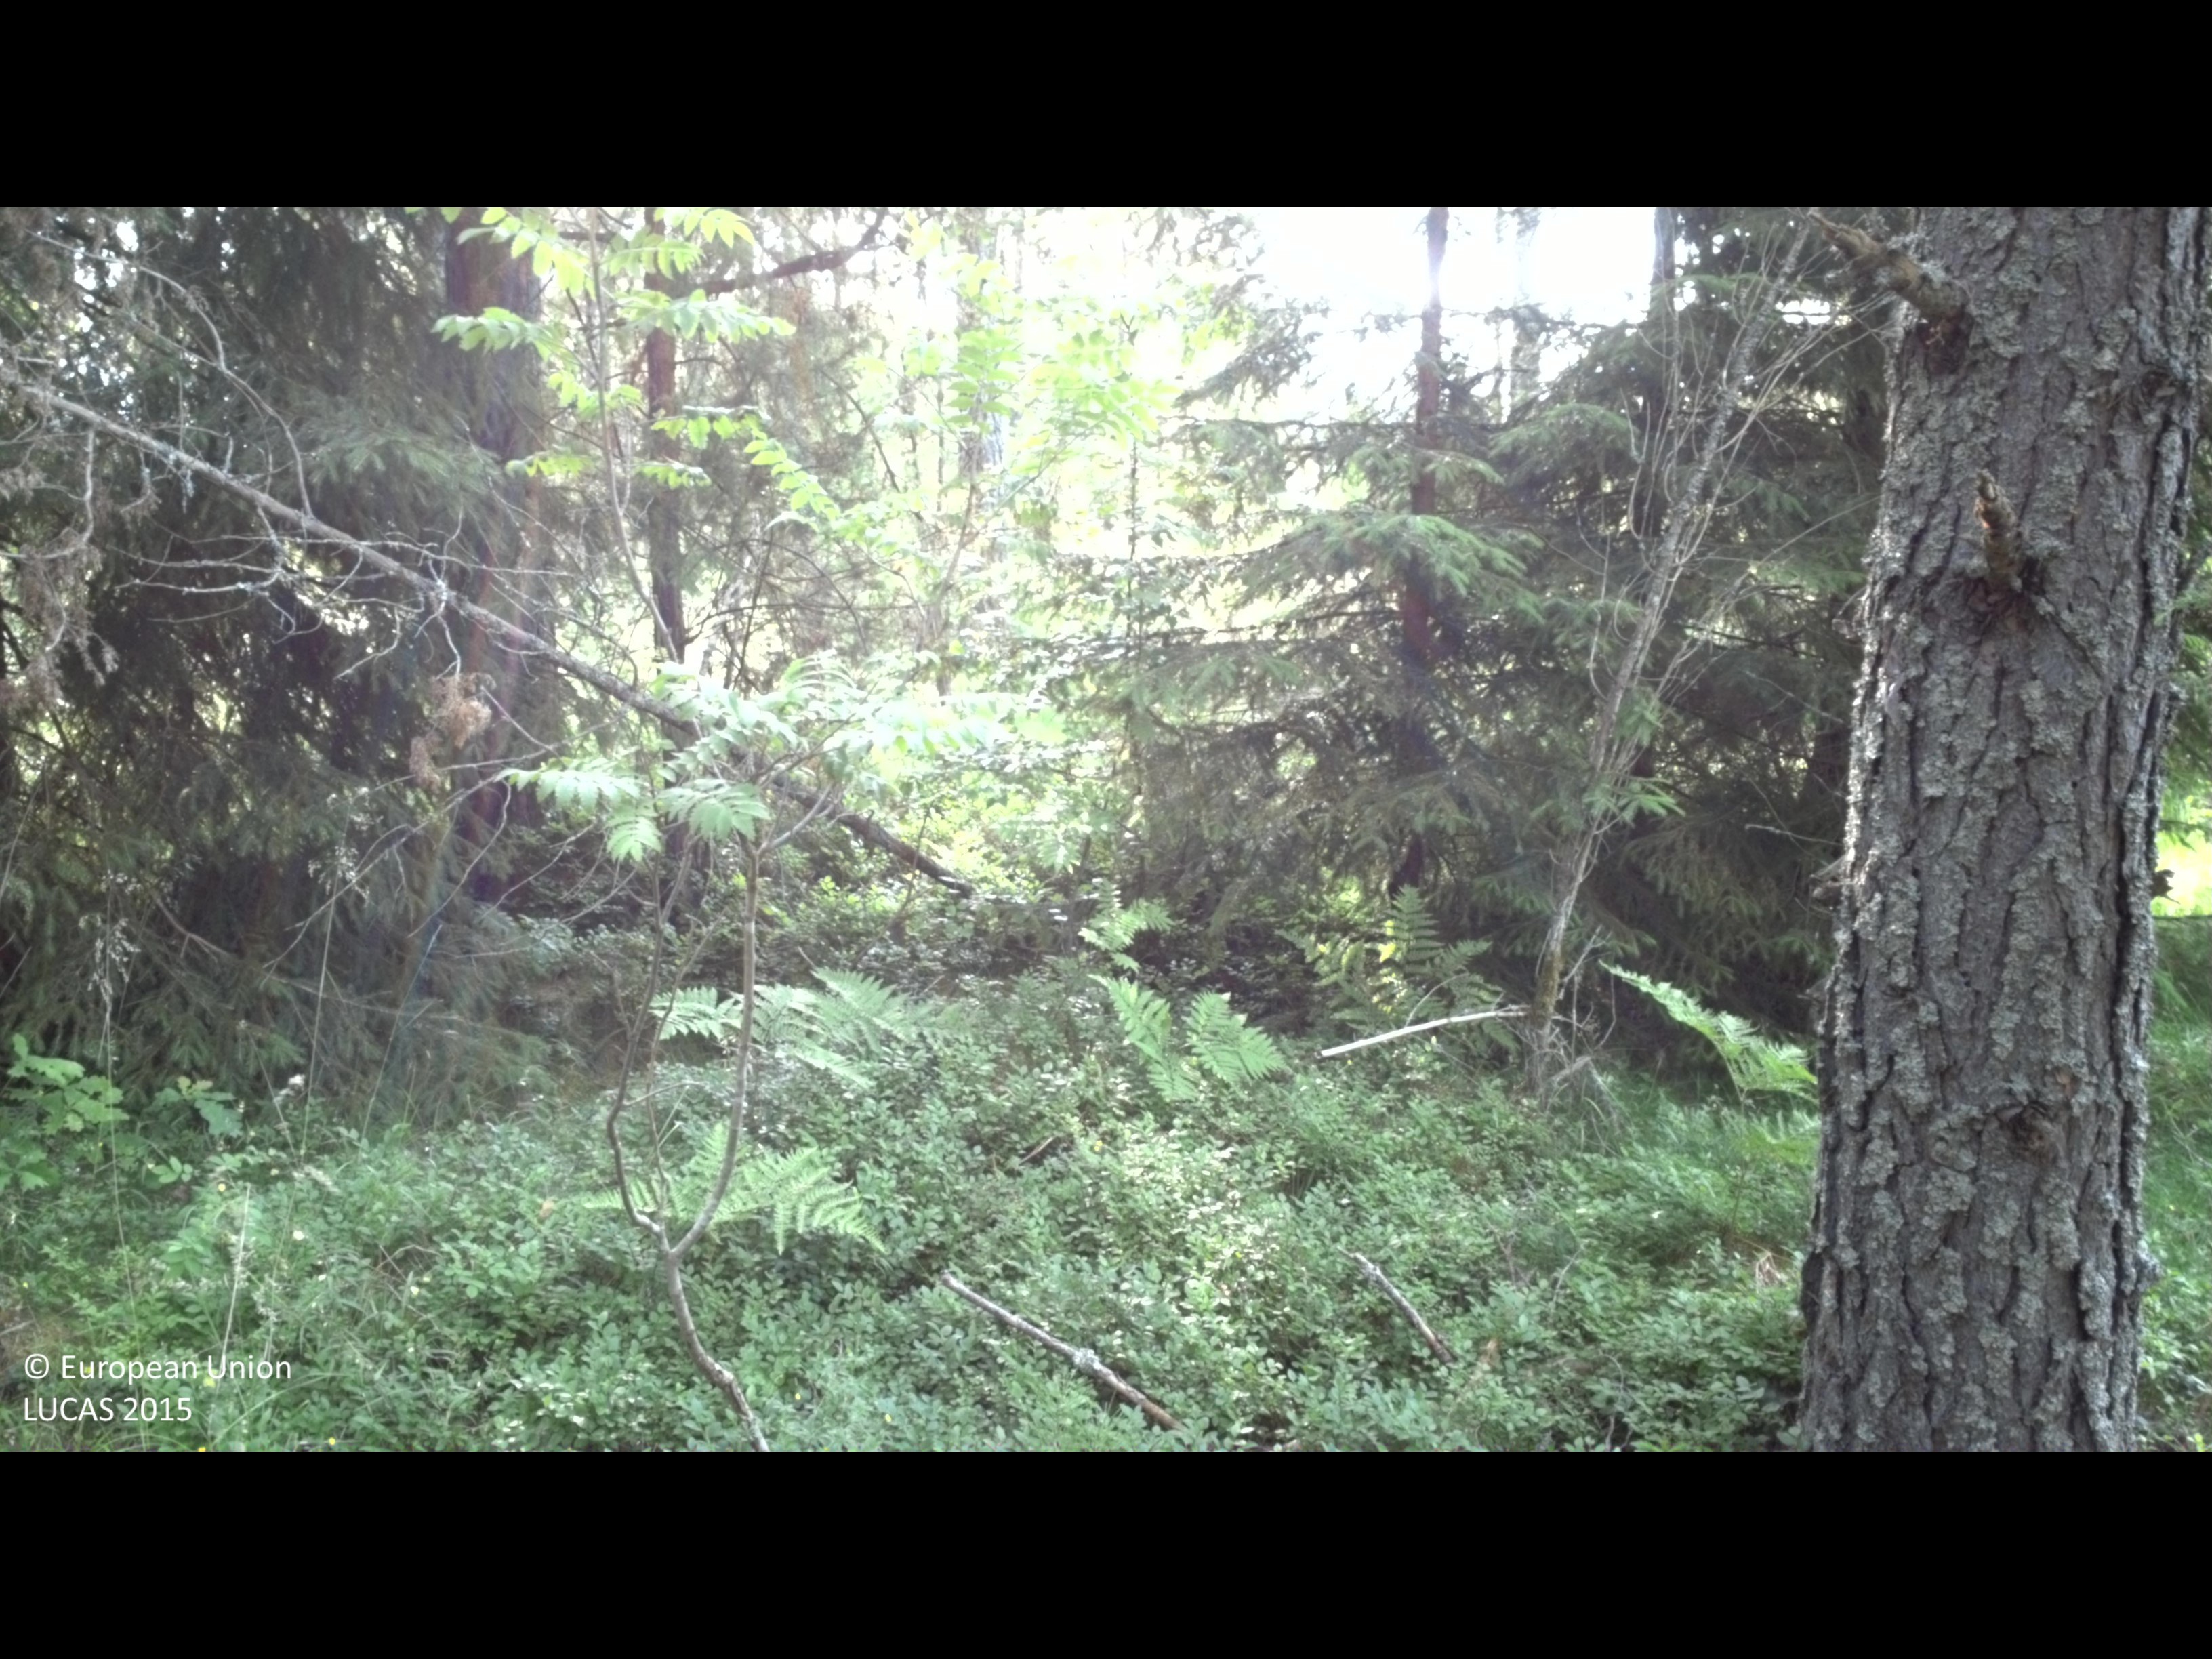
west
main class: Woodland
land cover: Pine dominated coniferous woodland
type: boreal forest
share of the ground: 50 - 75 %
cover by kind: coniferous forest trees 65 %, shrubs 20 %, herbaceous plants 10 %, broadleaved forest trees 5 %
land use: Forestry
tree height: > 5 m
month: July
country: SE
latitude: 58.3962
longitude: 16.6865
